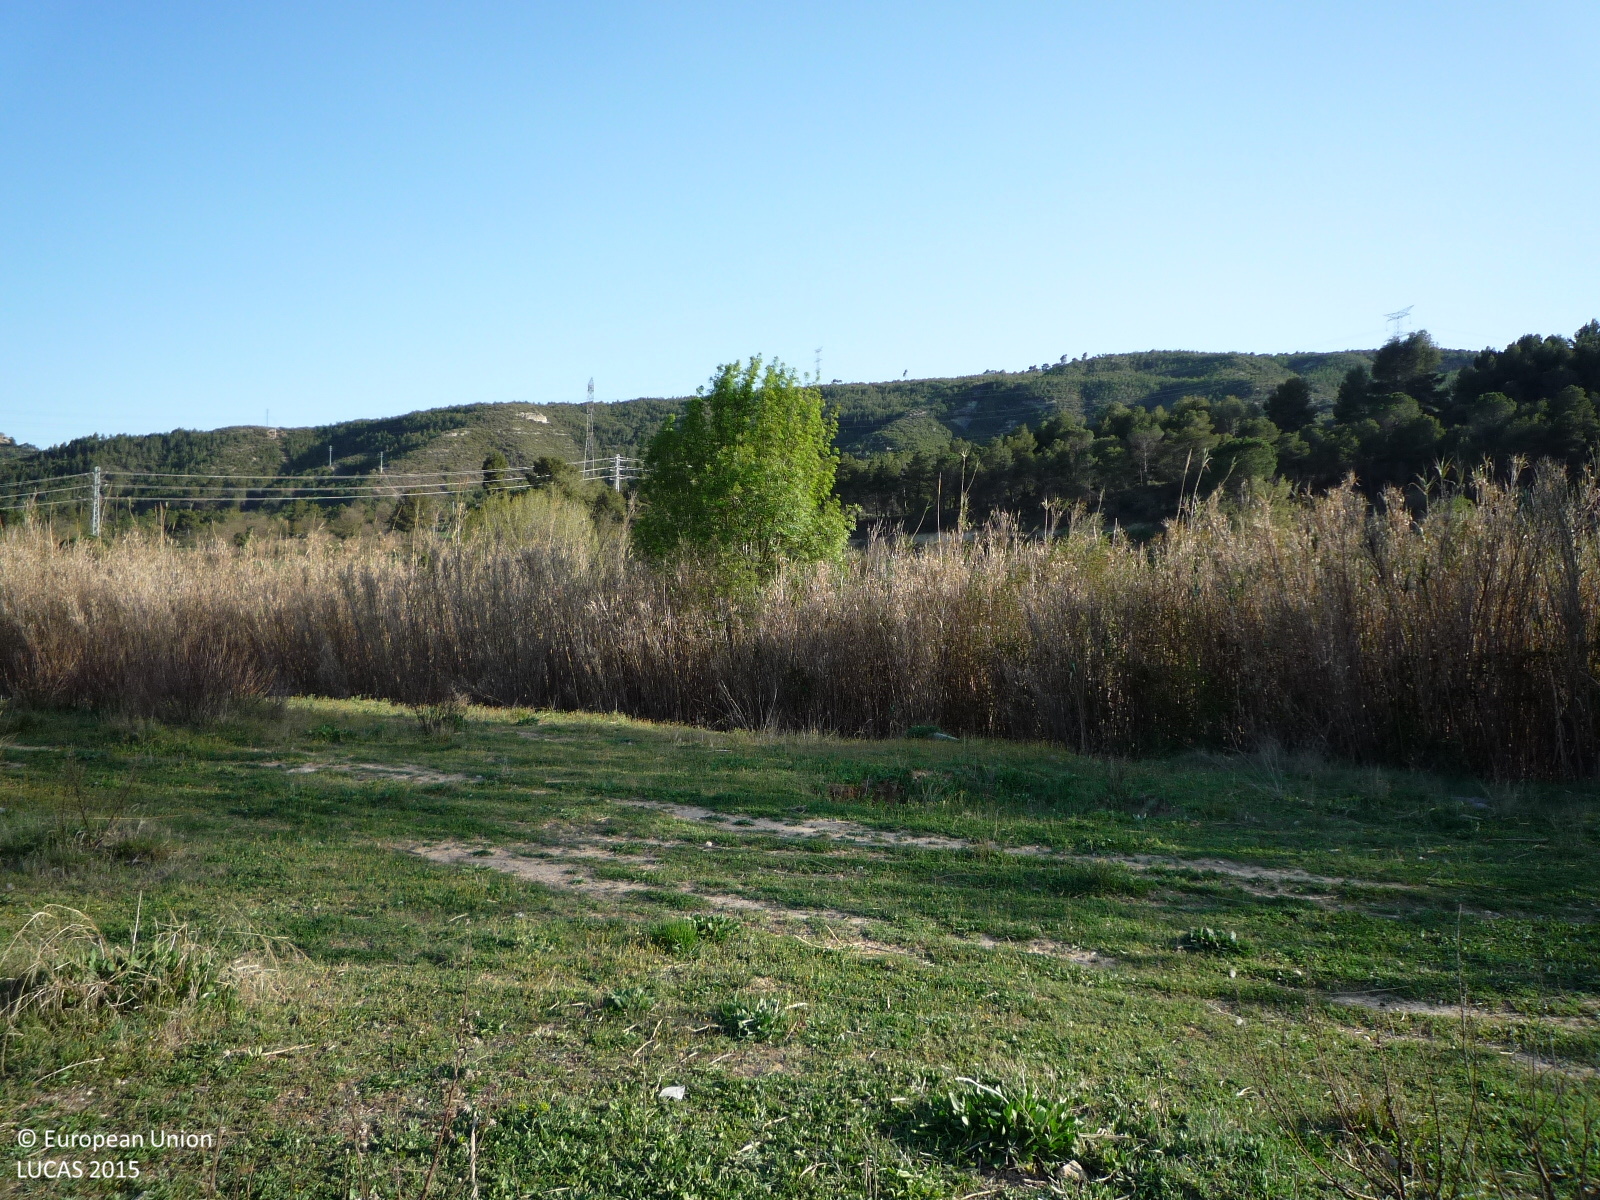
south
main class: Grassland
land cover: Grassland without tree/shrub cover
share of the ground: > 75 %
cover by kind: herbaceous plants 95 %, shrubs 5 %
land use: Abandoned areas
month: April
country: ES
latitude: 41.5651
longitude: 1.6577
